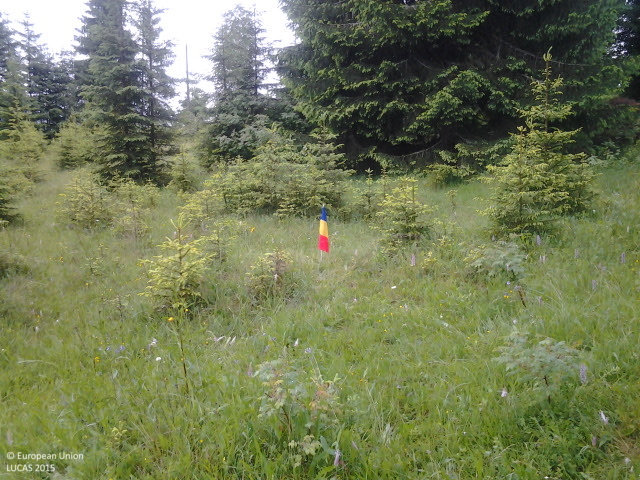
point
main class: Grassland
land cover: Grassland with sparse tree/shrub cover
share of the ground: > 75 %
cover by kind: herbaceous plants 90 %, coniferous forest trees 5 %, shrubs 5 %
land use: Agriculture (excluding fallow land and kitchen gardens)
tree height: < 5 m
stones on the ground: < 10 %
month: June
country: RO
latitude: 47.2294
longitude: 25.3658
